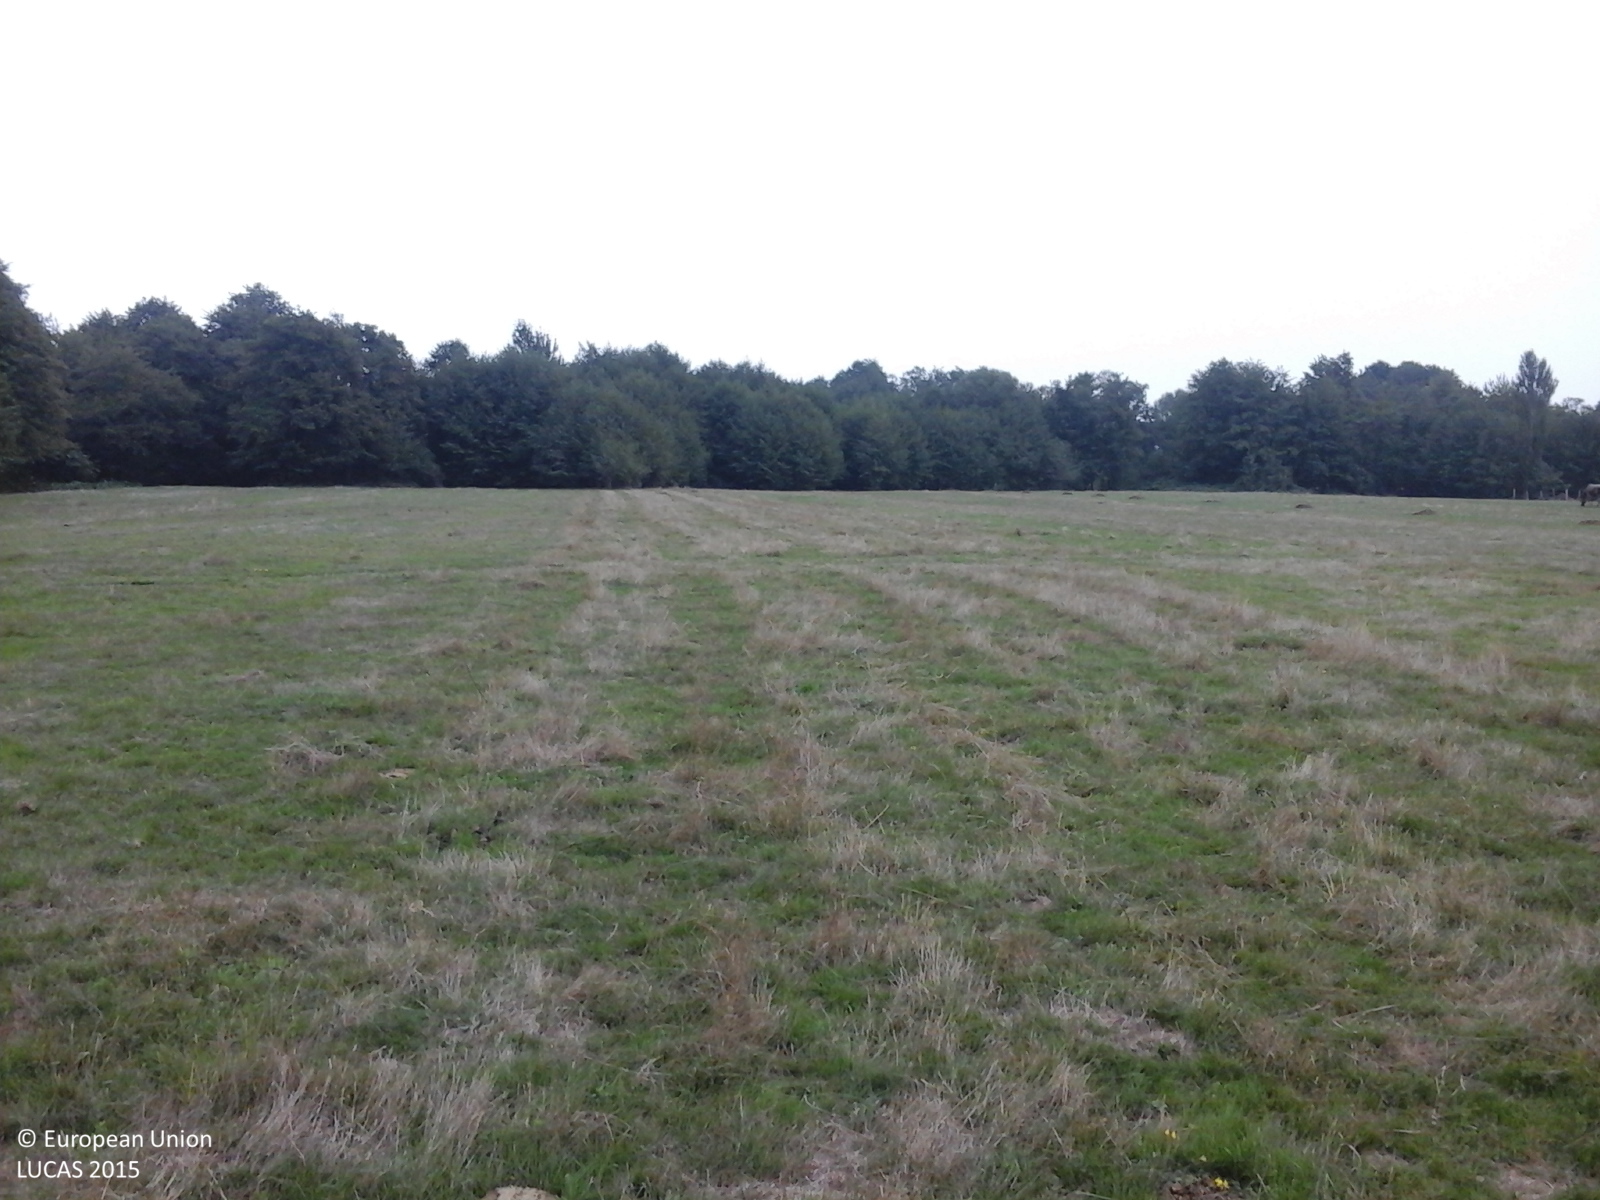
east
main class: Grassland
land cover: Grassland without tree/shrub cover
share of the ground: > 75 %
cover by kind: herbaceous plants 100 %
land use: Agriculture (excluding fallow land and kitchen gardens)
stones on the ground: < 10 %
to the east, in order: Grassland without tree/shrub cover; Tracks; Grassland without tree/shrub cover; Broadleaved woodland; Ditches and canals; Broadleaved woodland; Grassland with sparse tree/shrub cover; Broadleaved woodland
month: September
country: RO
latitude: 45.1019
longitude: 23.2581
